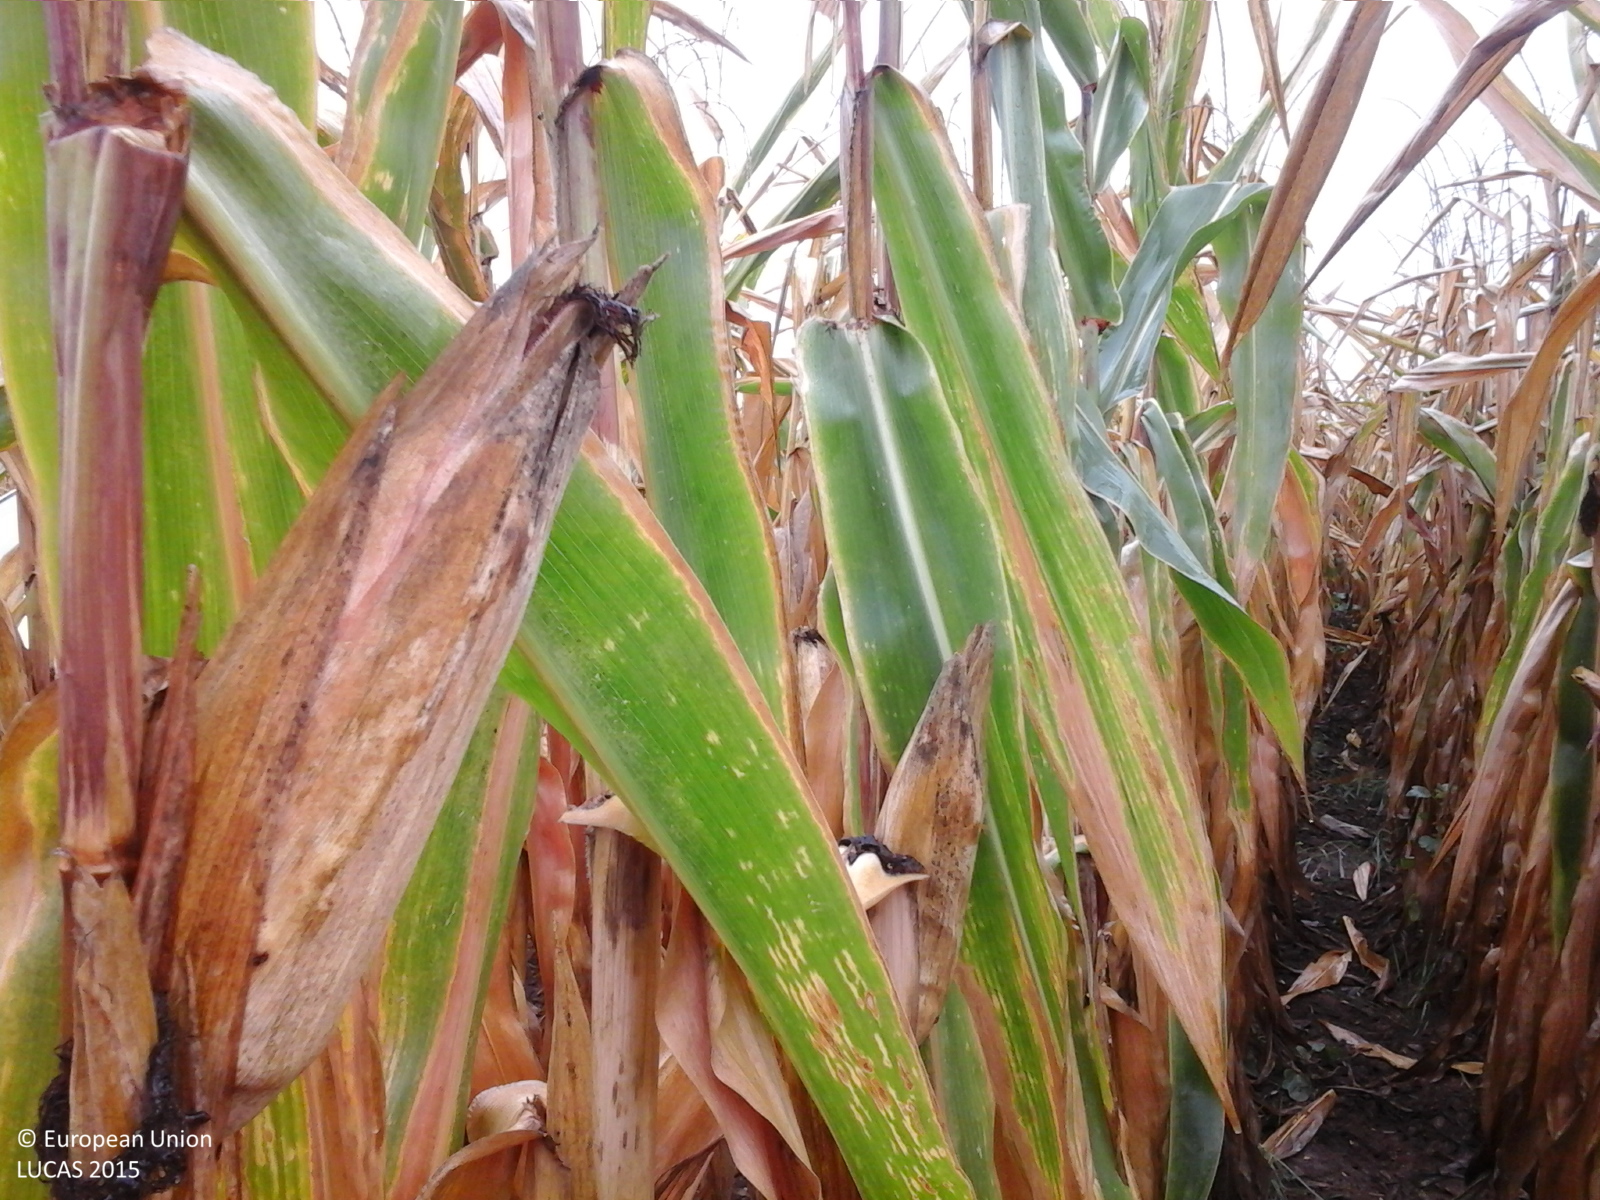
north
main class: Cropland
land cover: Maize
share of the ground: > 75 %
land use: Agriculture (excluding fallow land and kitchen gardens)
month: September
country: RO
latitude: 47.4888
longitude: 22.1966
